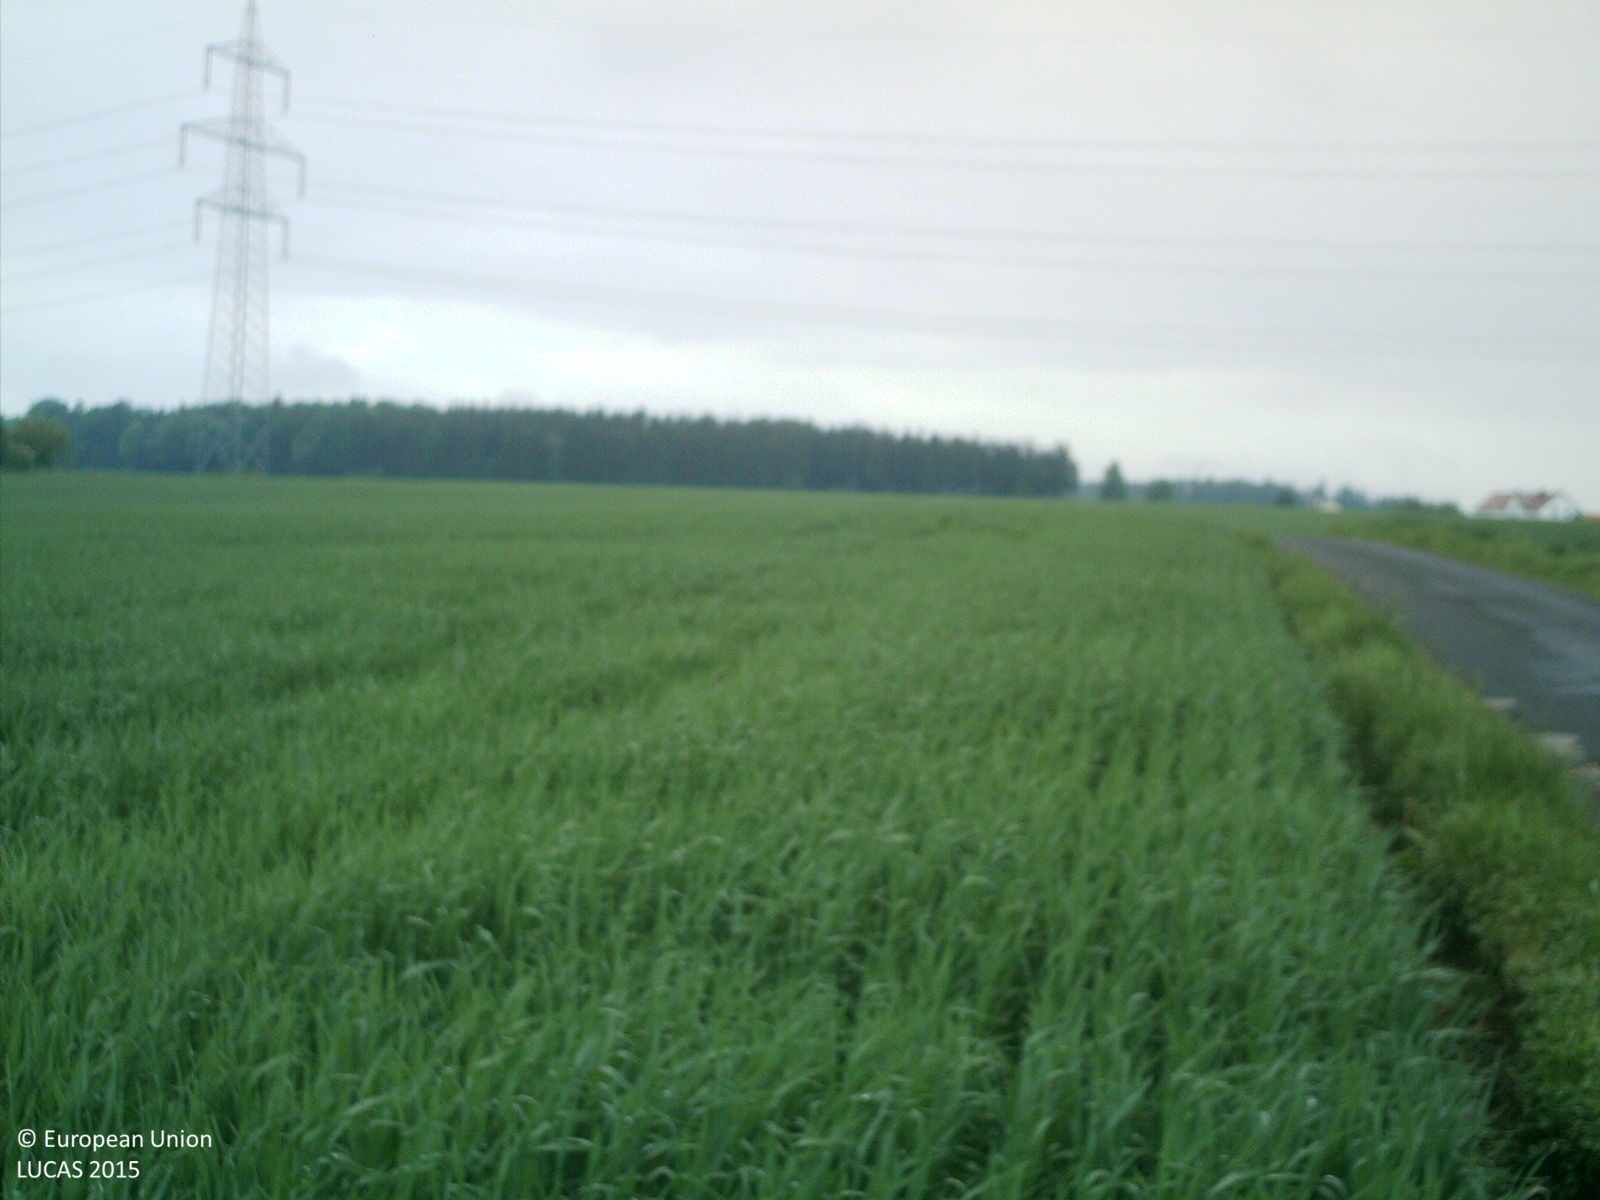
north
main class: Cropland
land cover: Oats
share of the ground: > 75 %
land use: Agriculture (excluding fallow land and kitchen gardens)
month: May
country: AT
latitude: 48.0874
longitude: 14.2556
